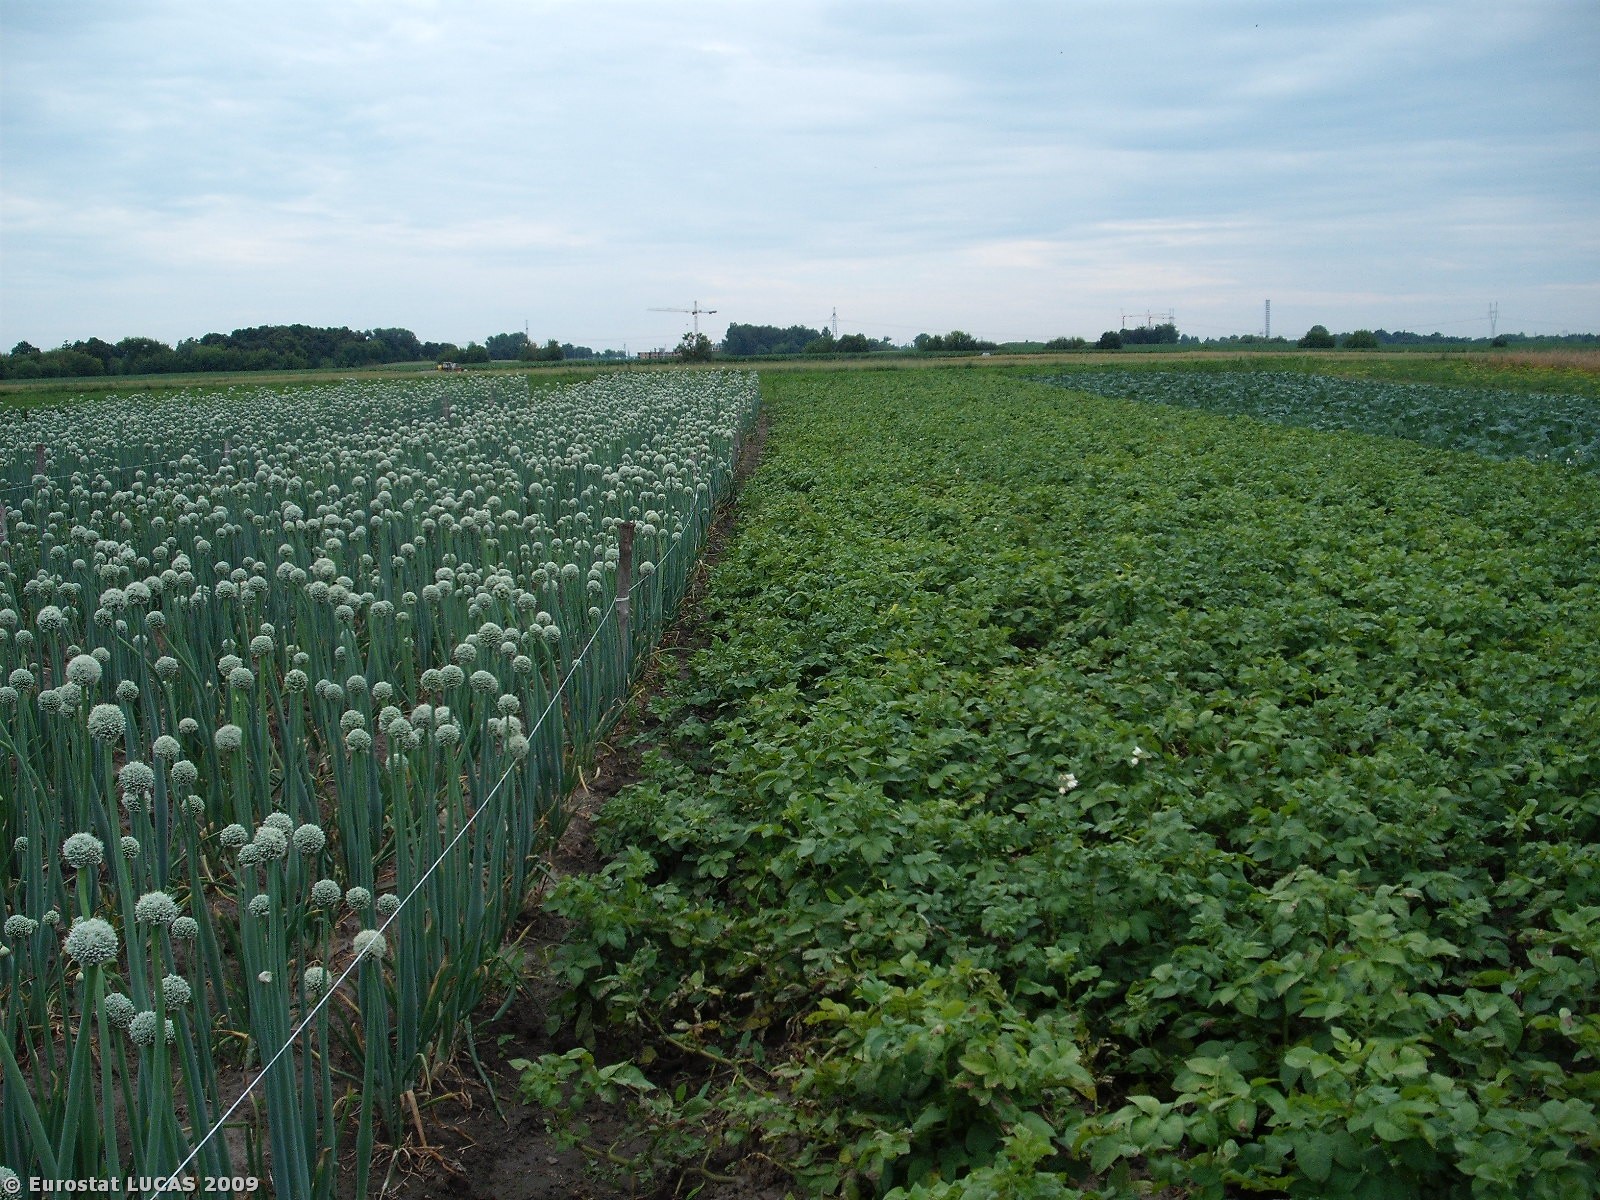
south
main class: Cropland
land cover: Potatoes
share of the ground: > 75 %
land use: Agriculture (excluding fallow land and kitchen gardens)
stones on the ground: < 10 %
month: July
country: PL
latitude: 52.2481
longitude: 20.7778
